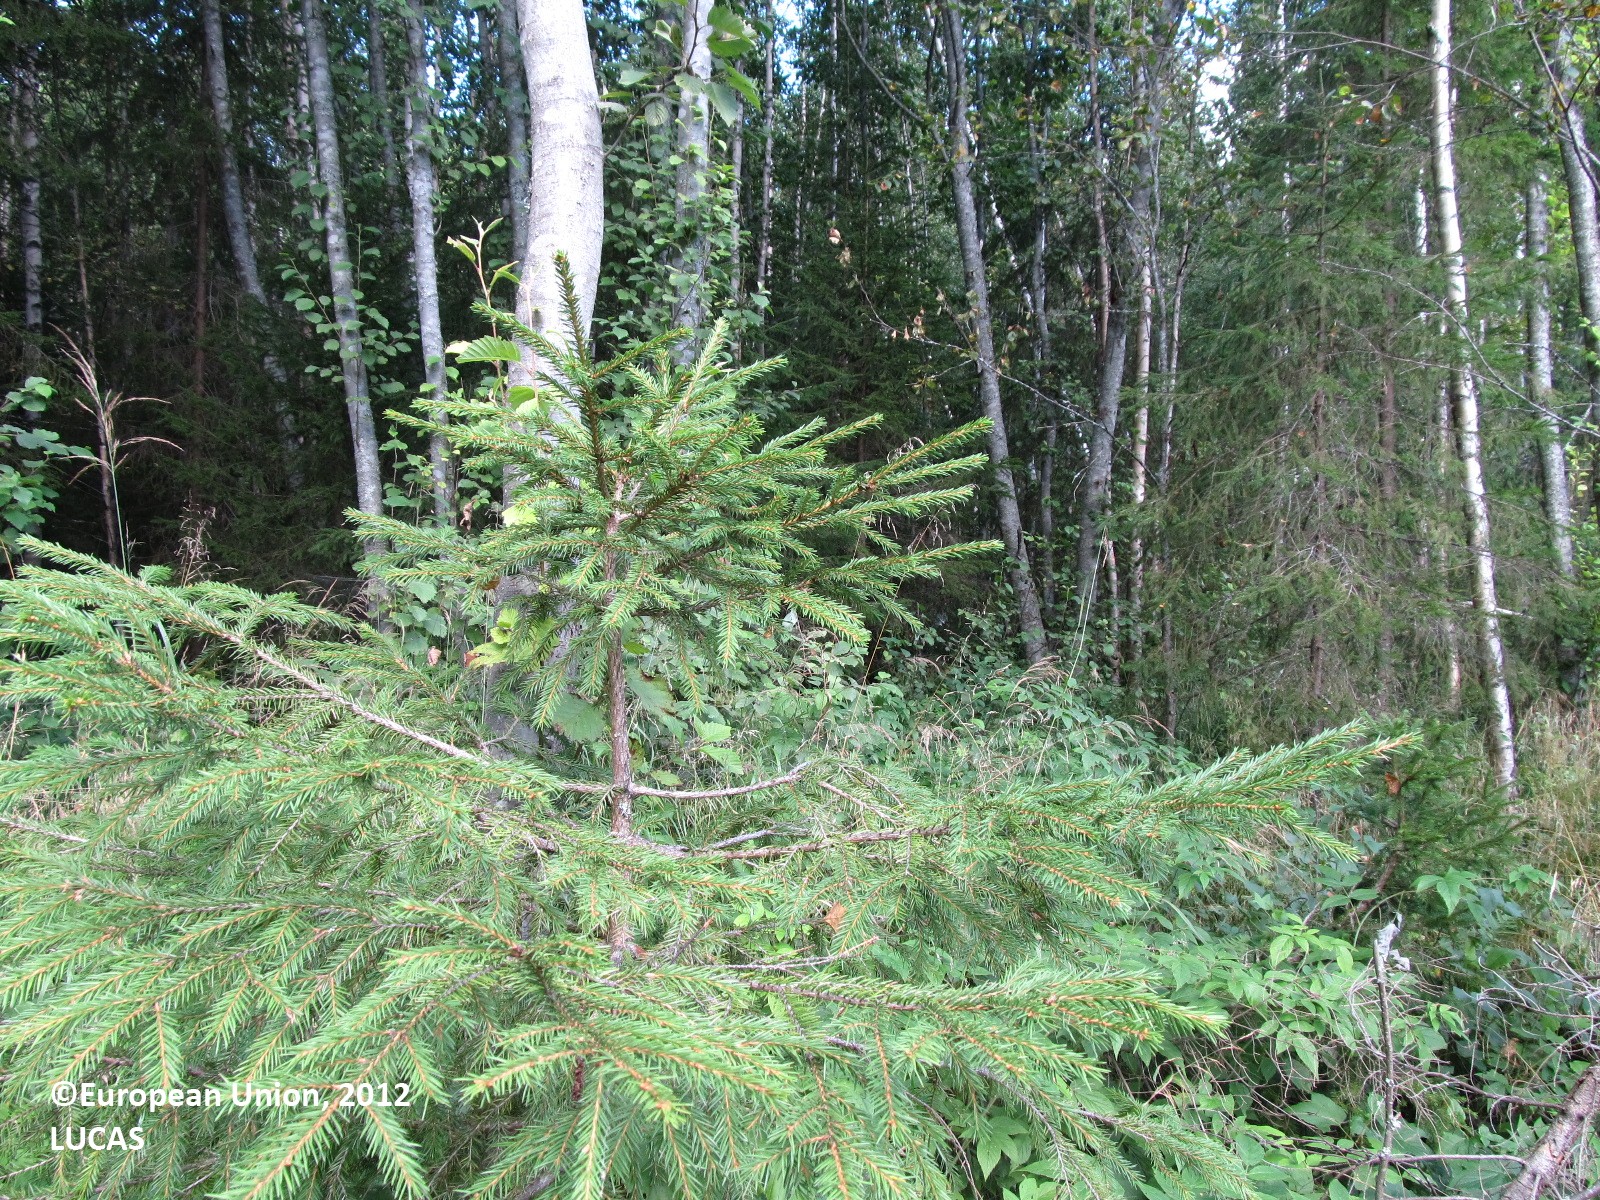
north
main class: Woodland
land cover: Spruce dominated mixed woodland
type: boreal forest
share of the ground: 25 - 50 %
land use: Forestry
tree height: > 5 m
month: August
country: FI
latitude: 62.2367
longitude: 27.5482
